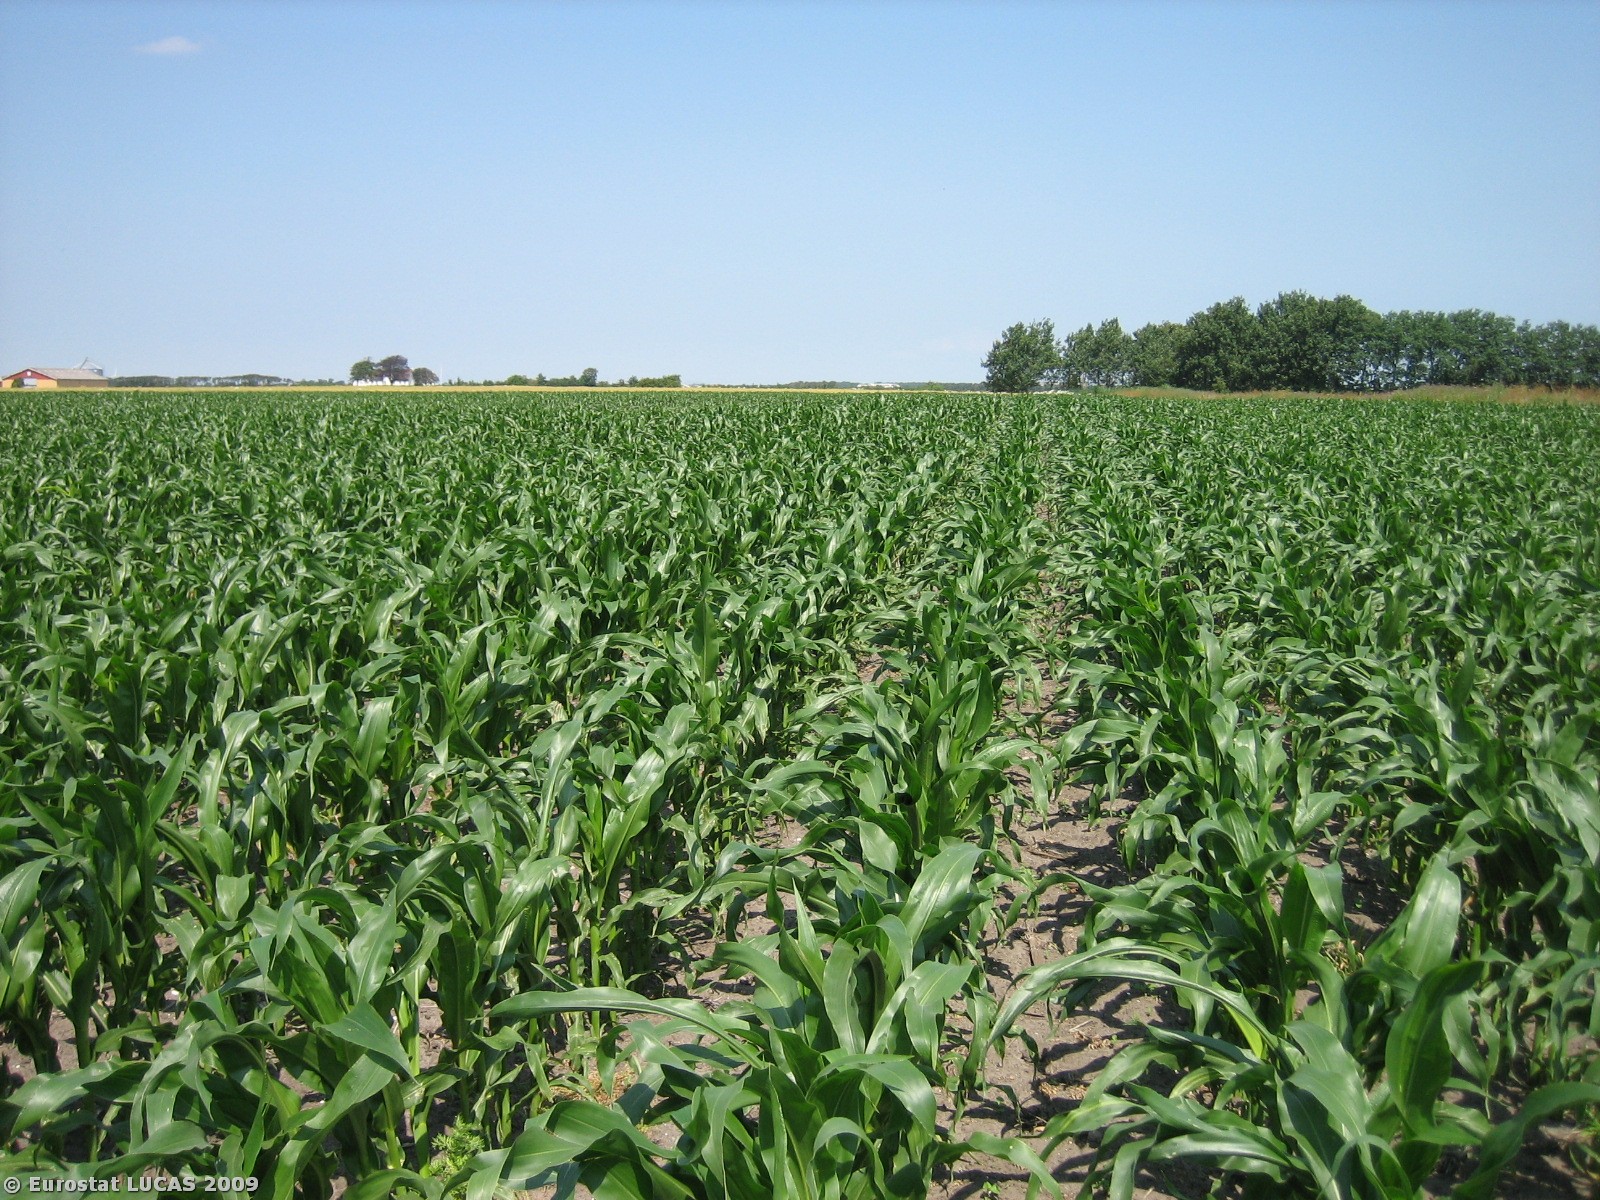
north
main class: Cropland
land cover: Maize
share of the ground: 50 - 75 %
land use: Agriculture (excluding fallow land and kitchen gardens)
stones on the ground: < 10 %
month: July
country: DK
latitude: 55.3545
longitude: 8.7235
